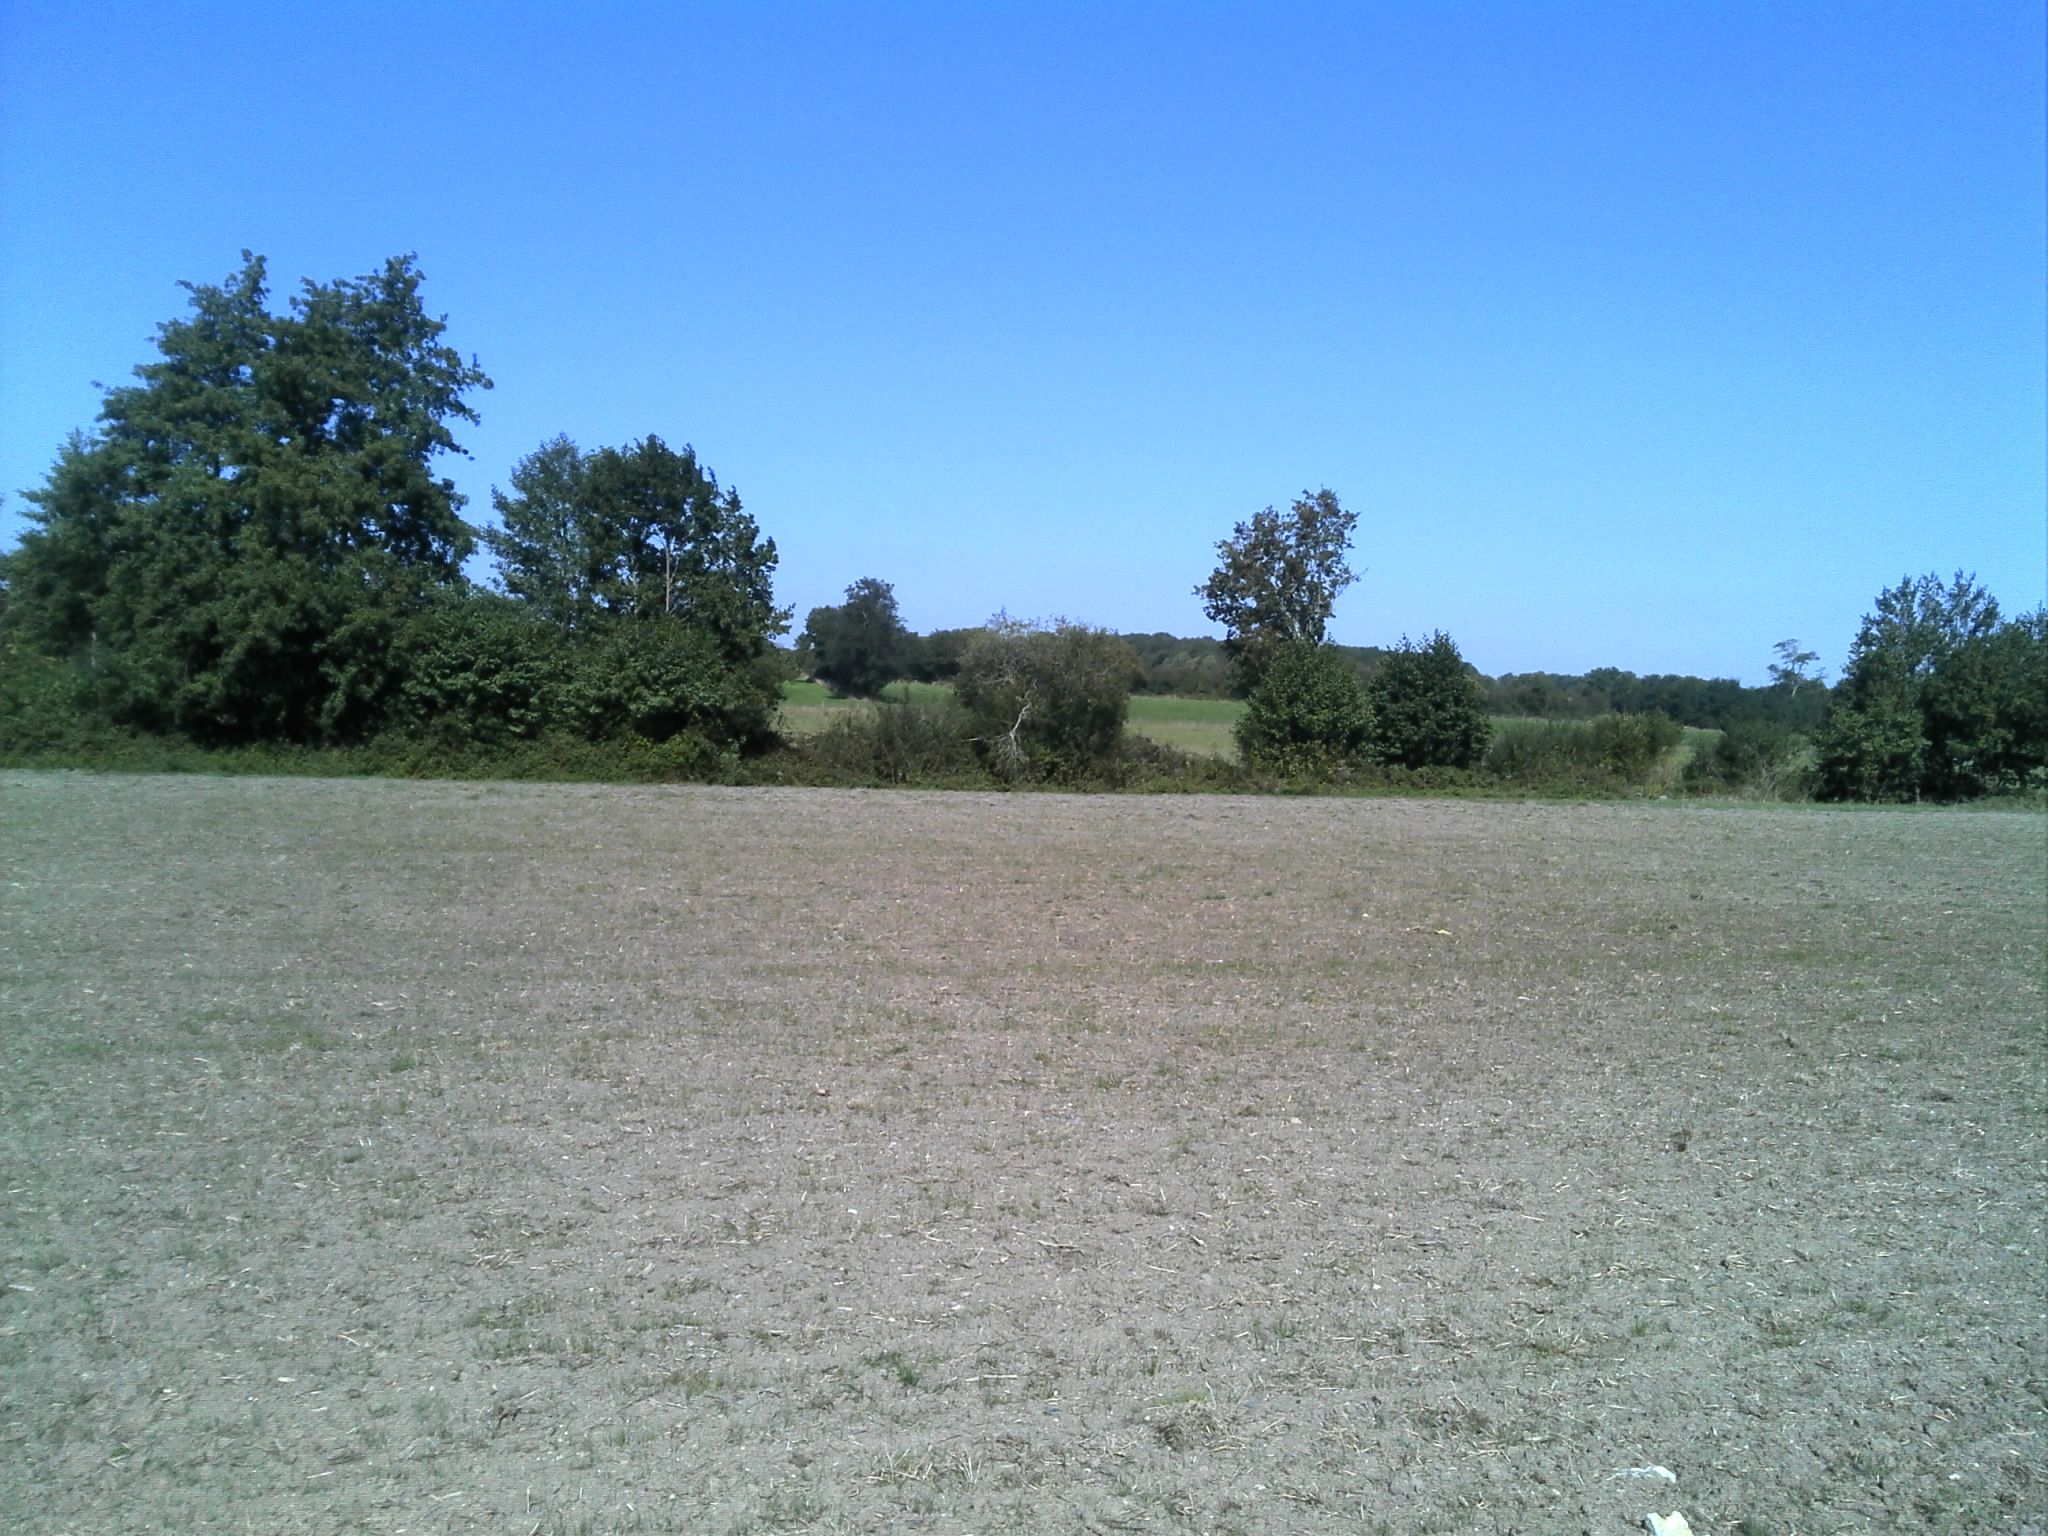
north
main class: Cropland
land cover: Temporary grasslands
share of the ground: 25 - 50 %
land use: Agriculture (excluding fallow land and kitchen gardens)
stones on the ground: < 10 %
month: October
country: FR
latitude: 47.5444
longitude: -0.9981
